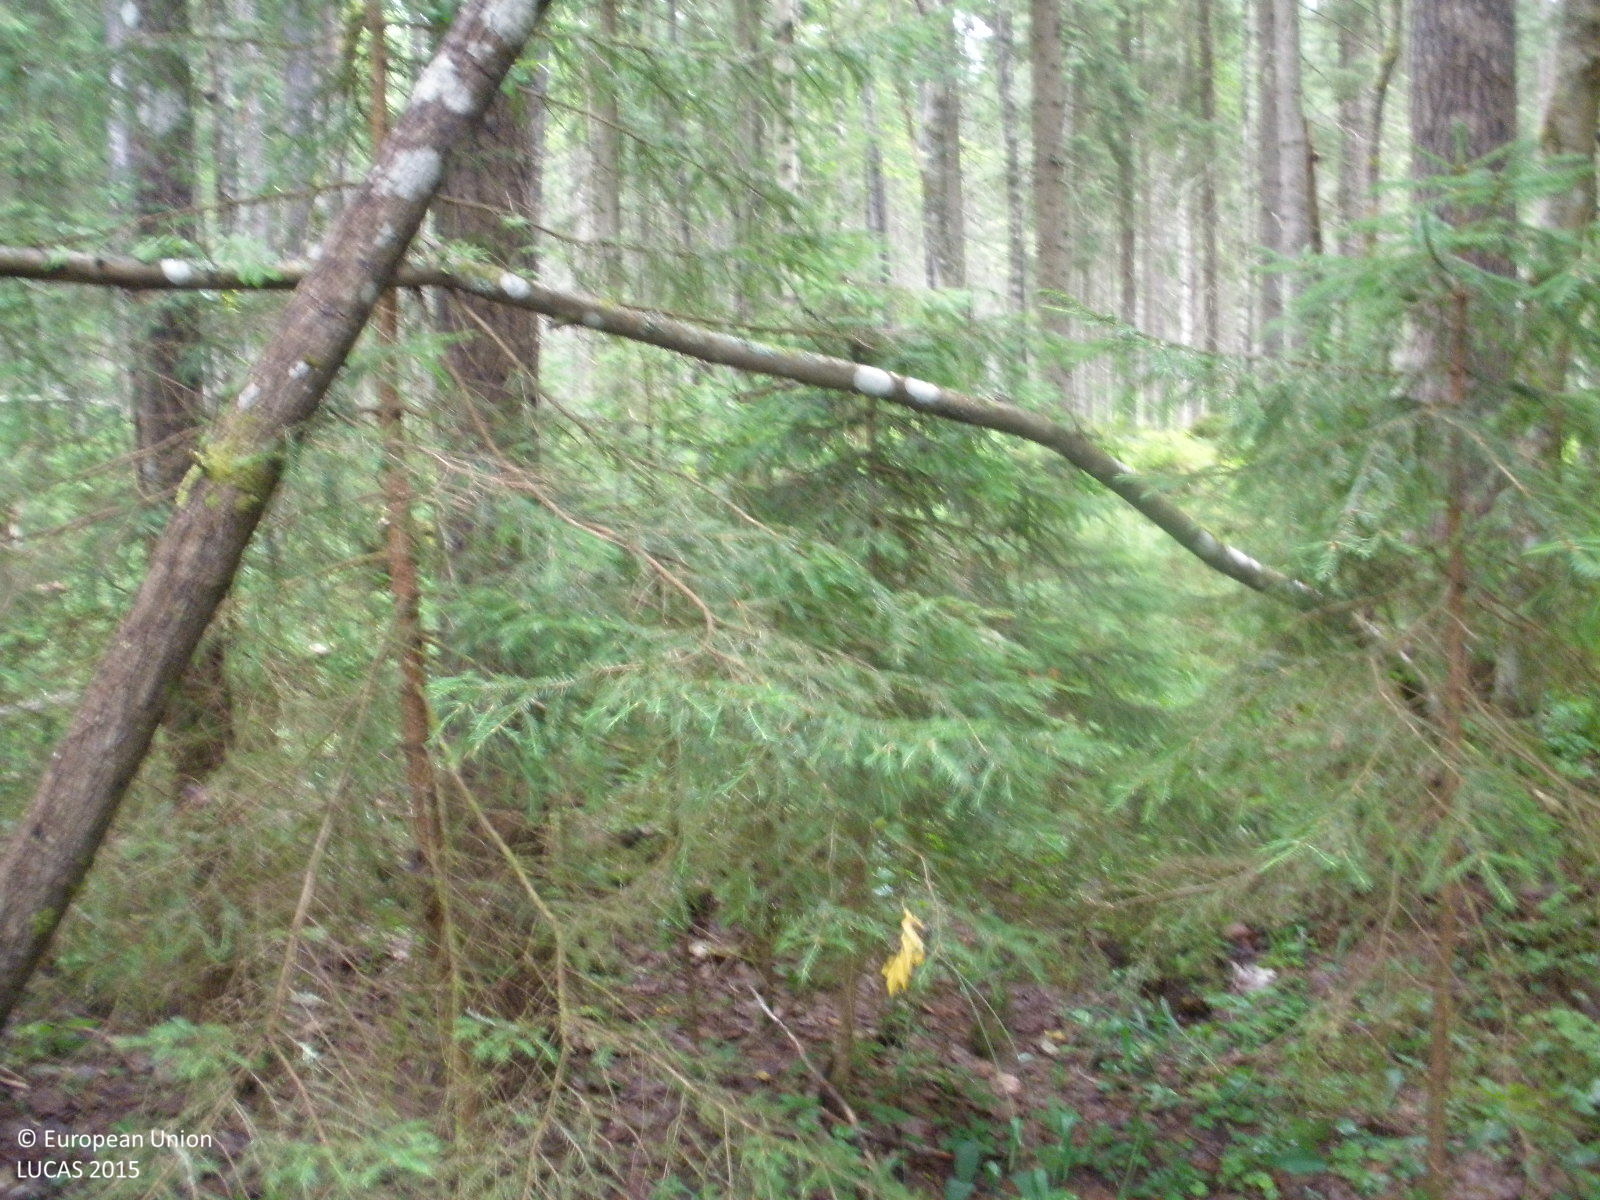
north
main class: Woodland
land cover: Spruce dominated mixed woodland
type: boreal forest
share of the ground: > 75 %
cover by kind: coniferous forest trees 55 %, broadleaved forest trees 30 %, herbaceous plants 15 %
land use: Forestry
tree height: > 5 m
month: July
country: FI
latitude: 61.4138
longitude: 24.8129
